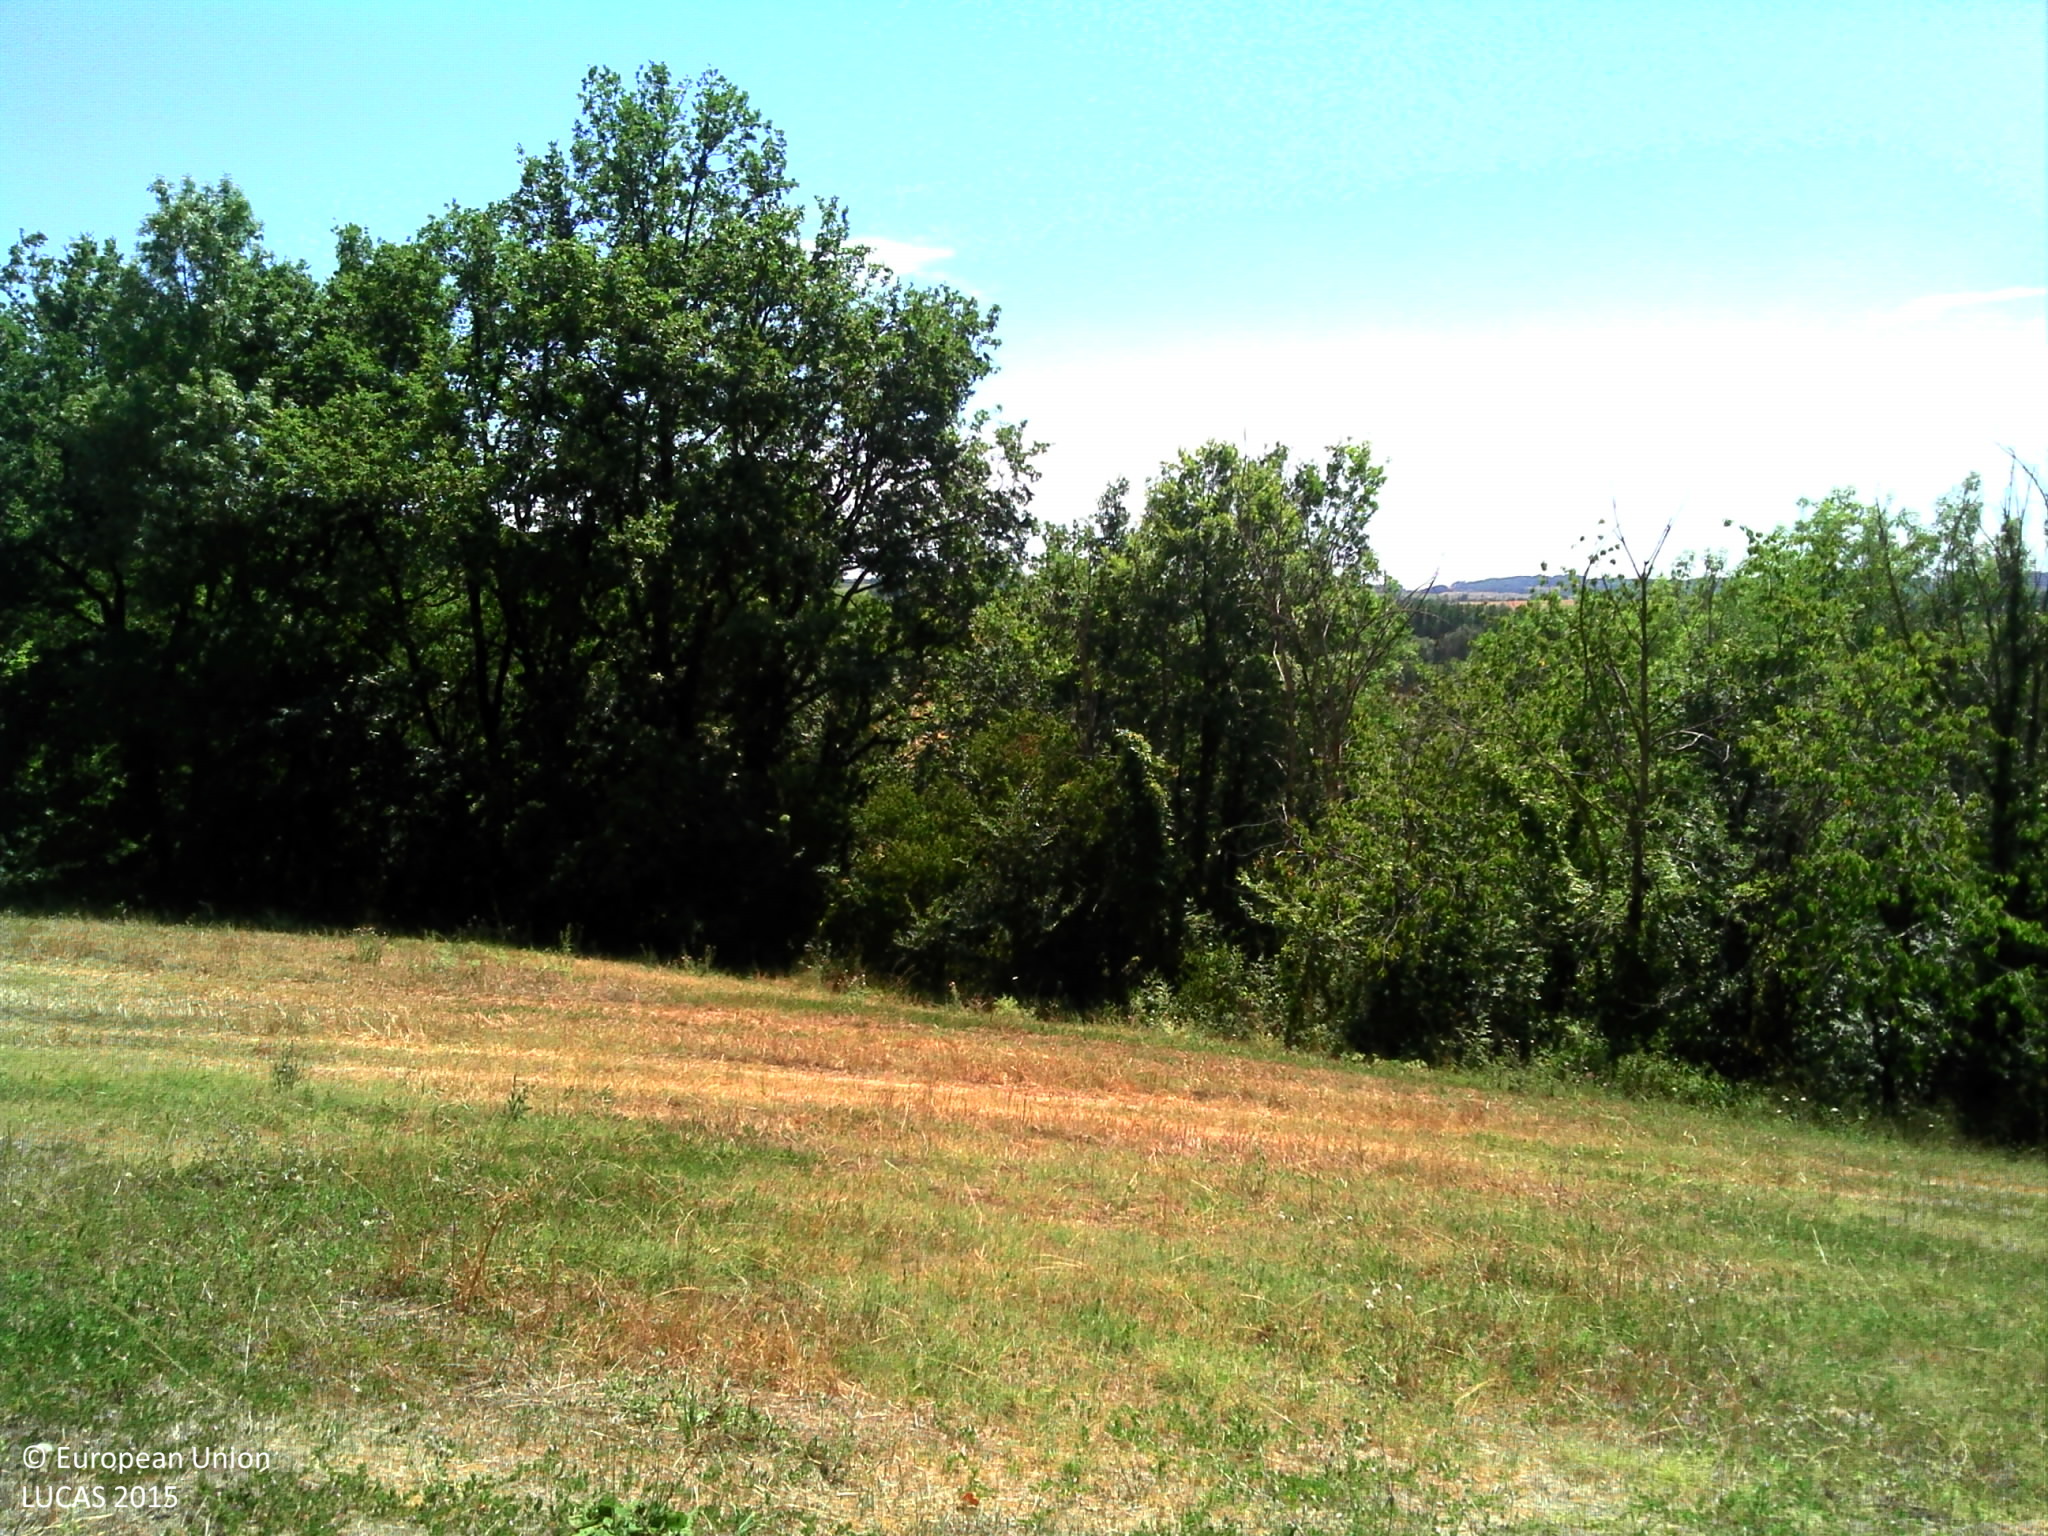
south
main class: Grassland
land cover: Grassland without tree/shrub cover
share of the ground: > 75 %
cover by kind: herbaceous plants 100 %
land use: Agriculture (excluding fallow land and kitchen gardens)
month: July
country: FR
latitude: 44.6152
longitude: 0.6293
